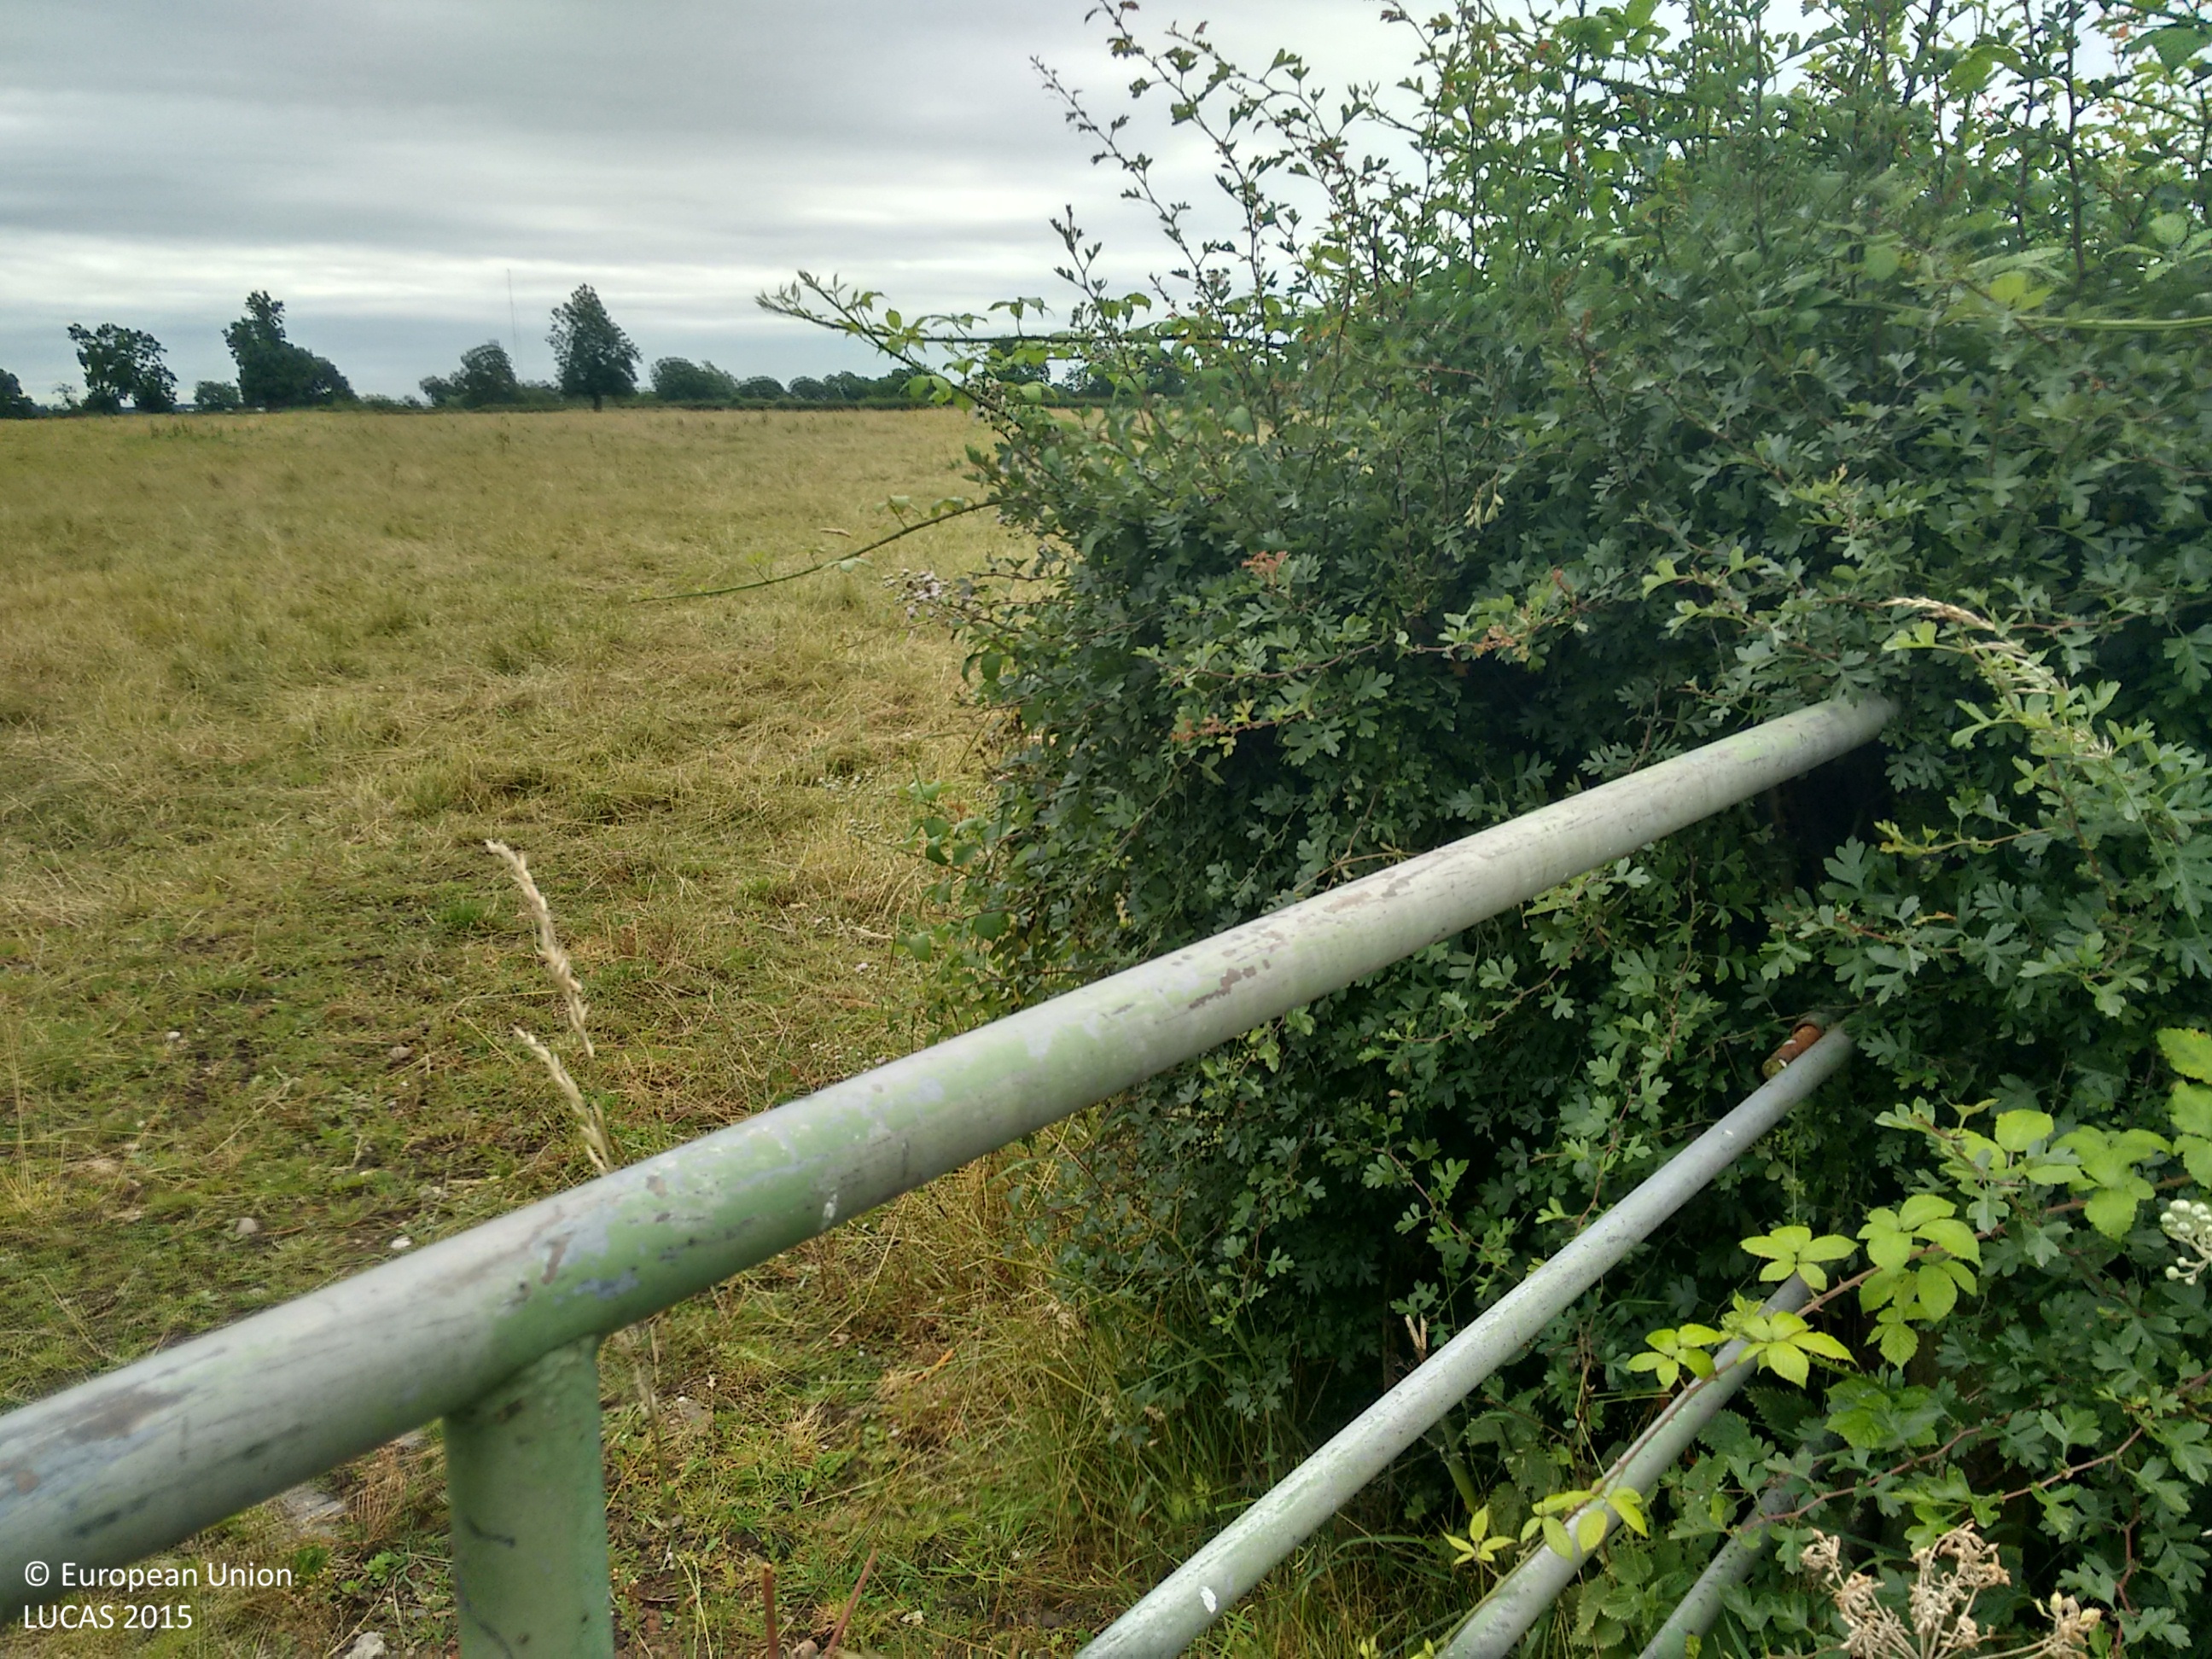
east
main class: Grassland
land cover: Grassland without tree/shrub cover
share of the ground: > 75 %
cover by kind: herbaceous plants 100 %
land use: Agriculture (excluding fallow land and kitchen gardens)
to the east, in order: Grassland without tree/shrub cover; Electric lines; Grassland without tree/shrub cover; Managed hedges; Grassland without tree/shrub cover
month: July
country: GB
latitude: 52.8817
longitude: -1.5681
